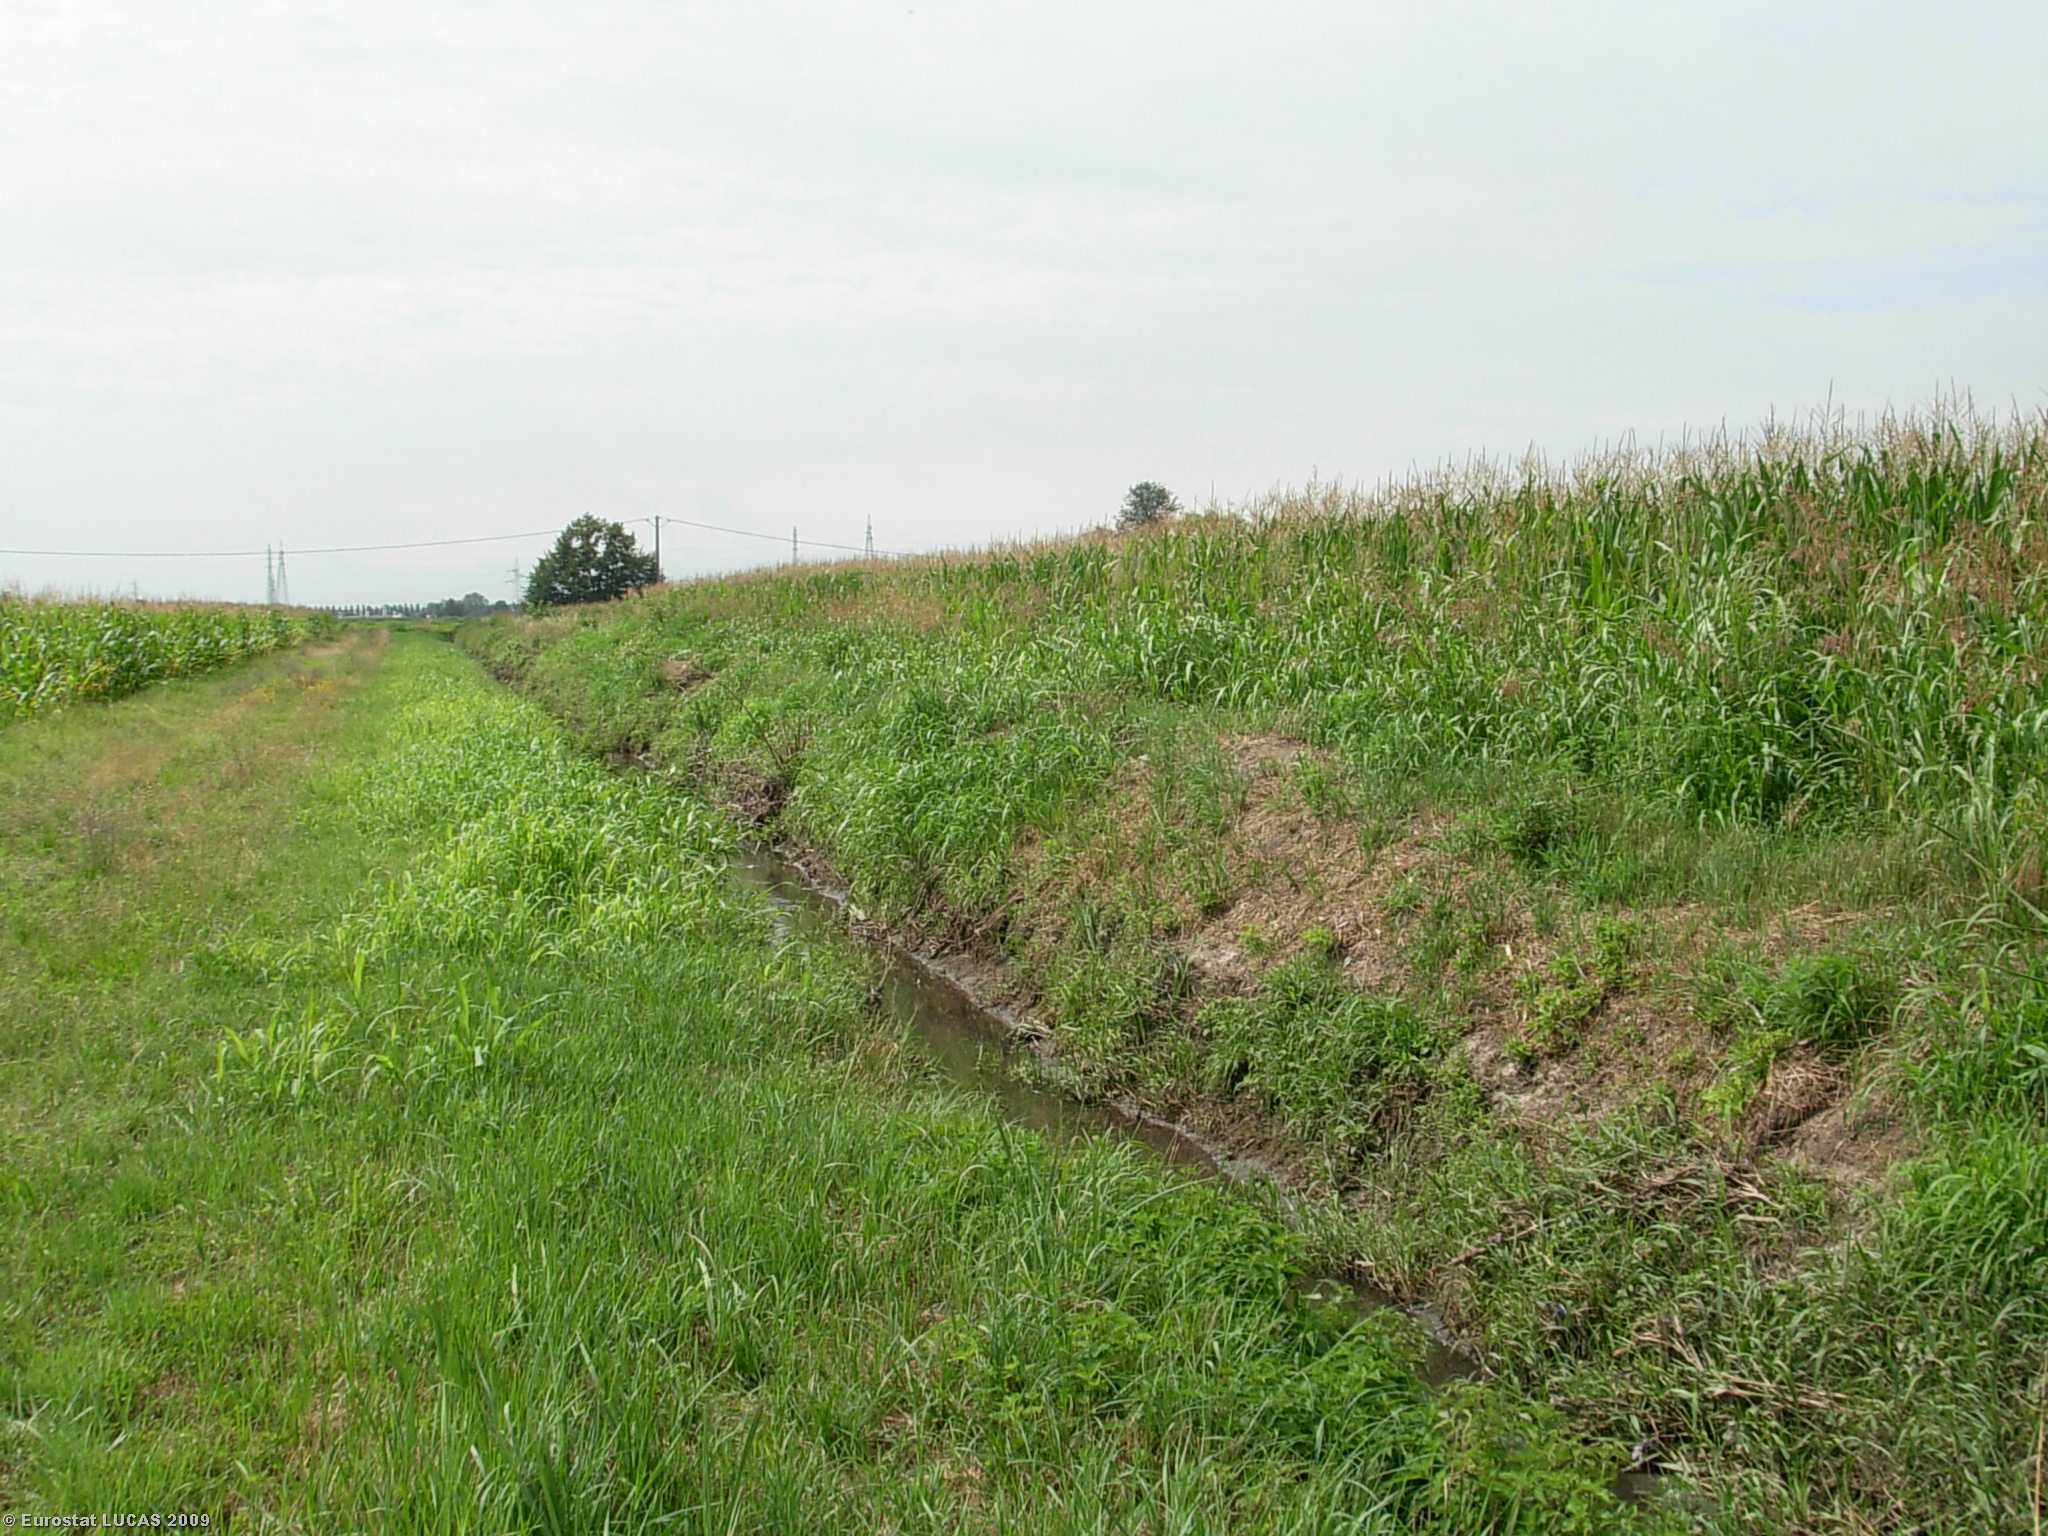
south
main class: Cropland
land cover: Maize
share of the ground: > 75 %
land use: Agriculture (excluding fallow land and kitchen gardens)
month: July
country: IT
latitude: 45.3757
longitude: 9.2734
